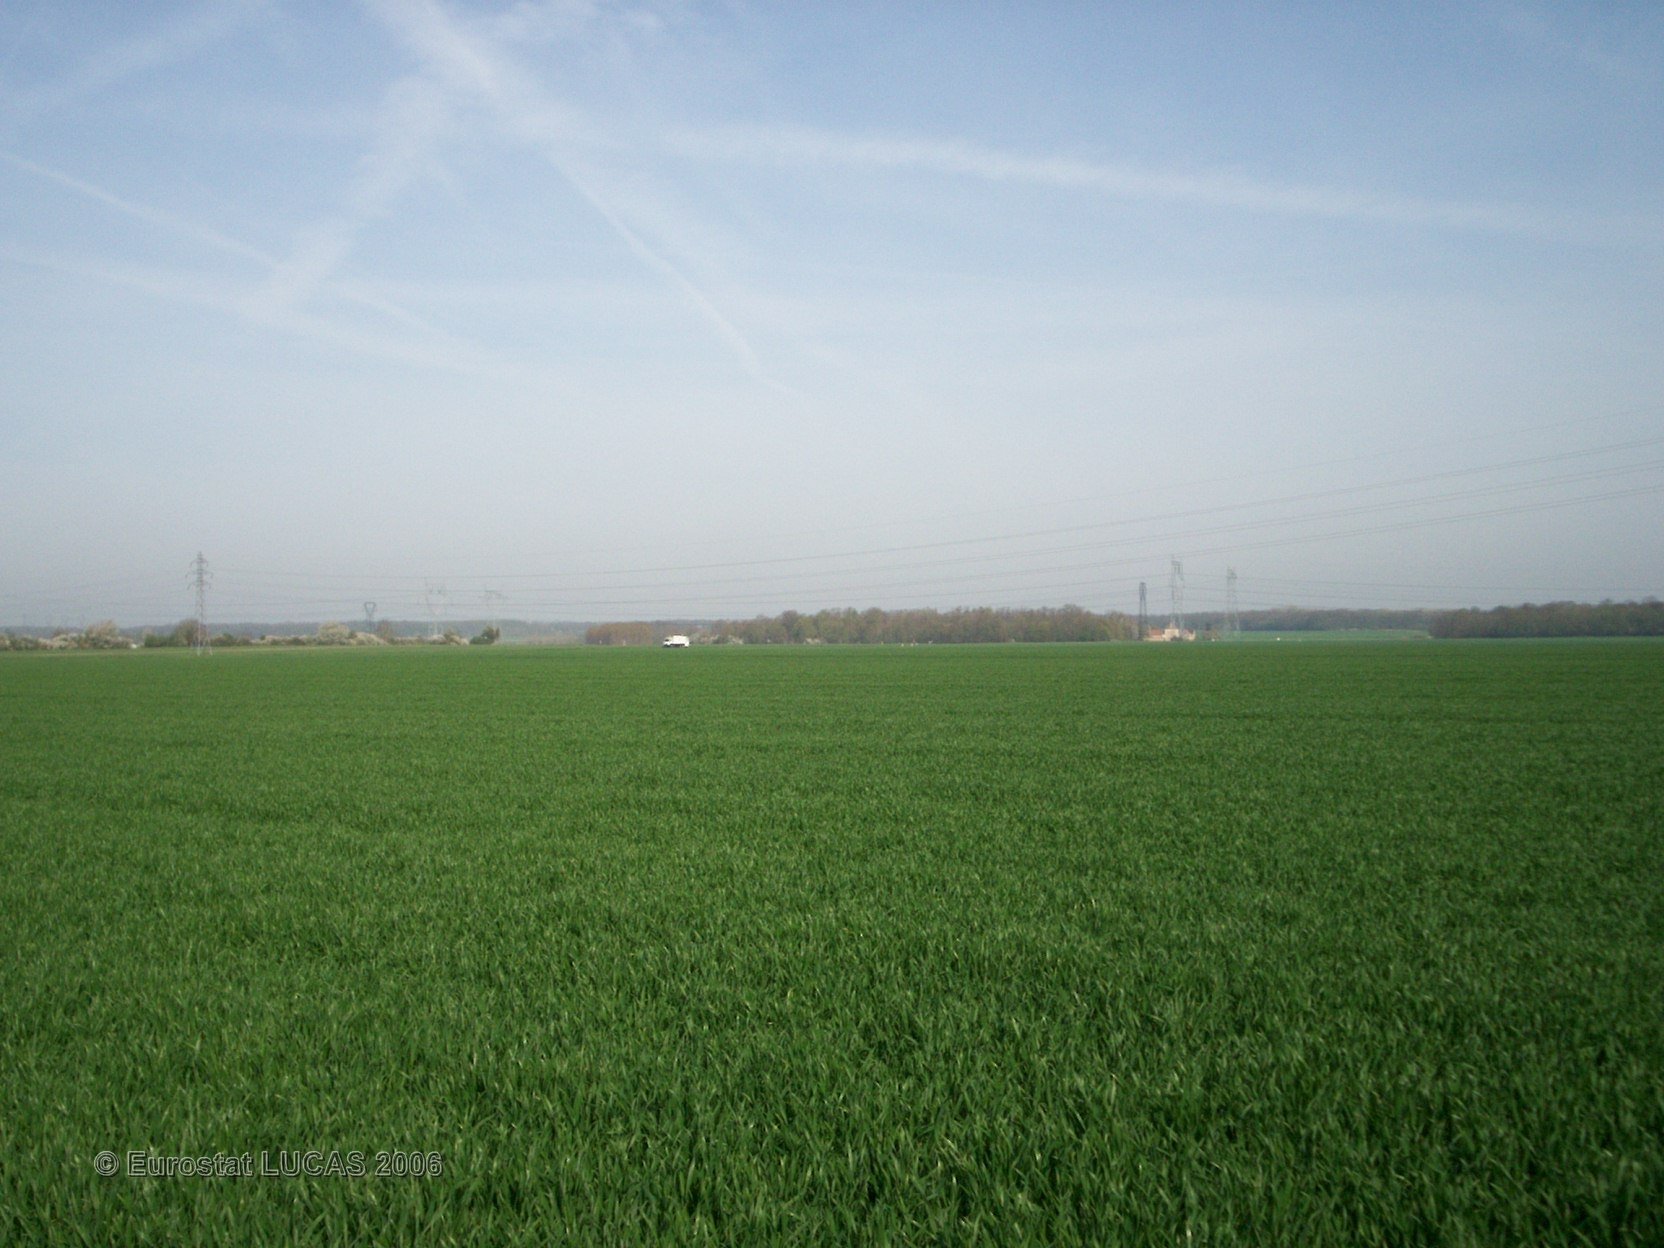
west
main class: Cropland
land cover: Barley
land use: Agriculture (excluding fallow land and kitchen gardens)
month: April
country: FR
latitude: 48.3920
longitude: 2.9015
